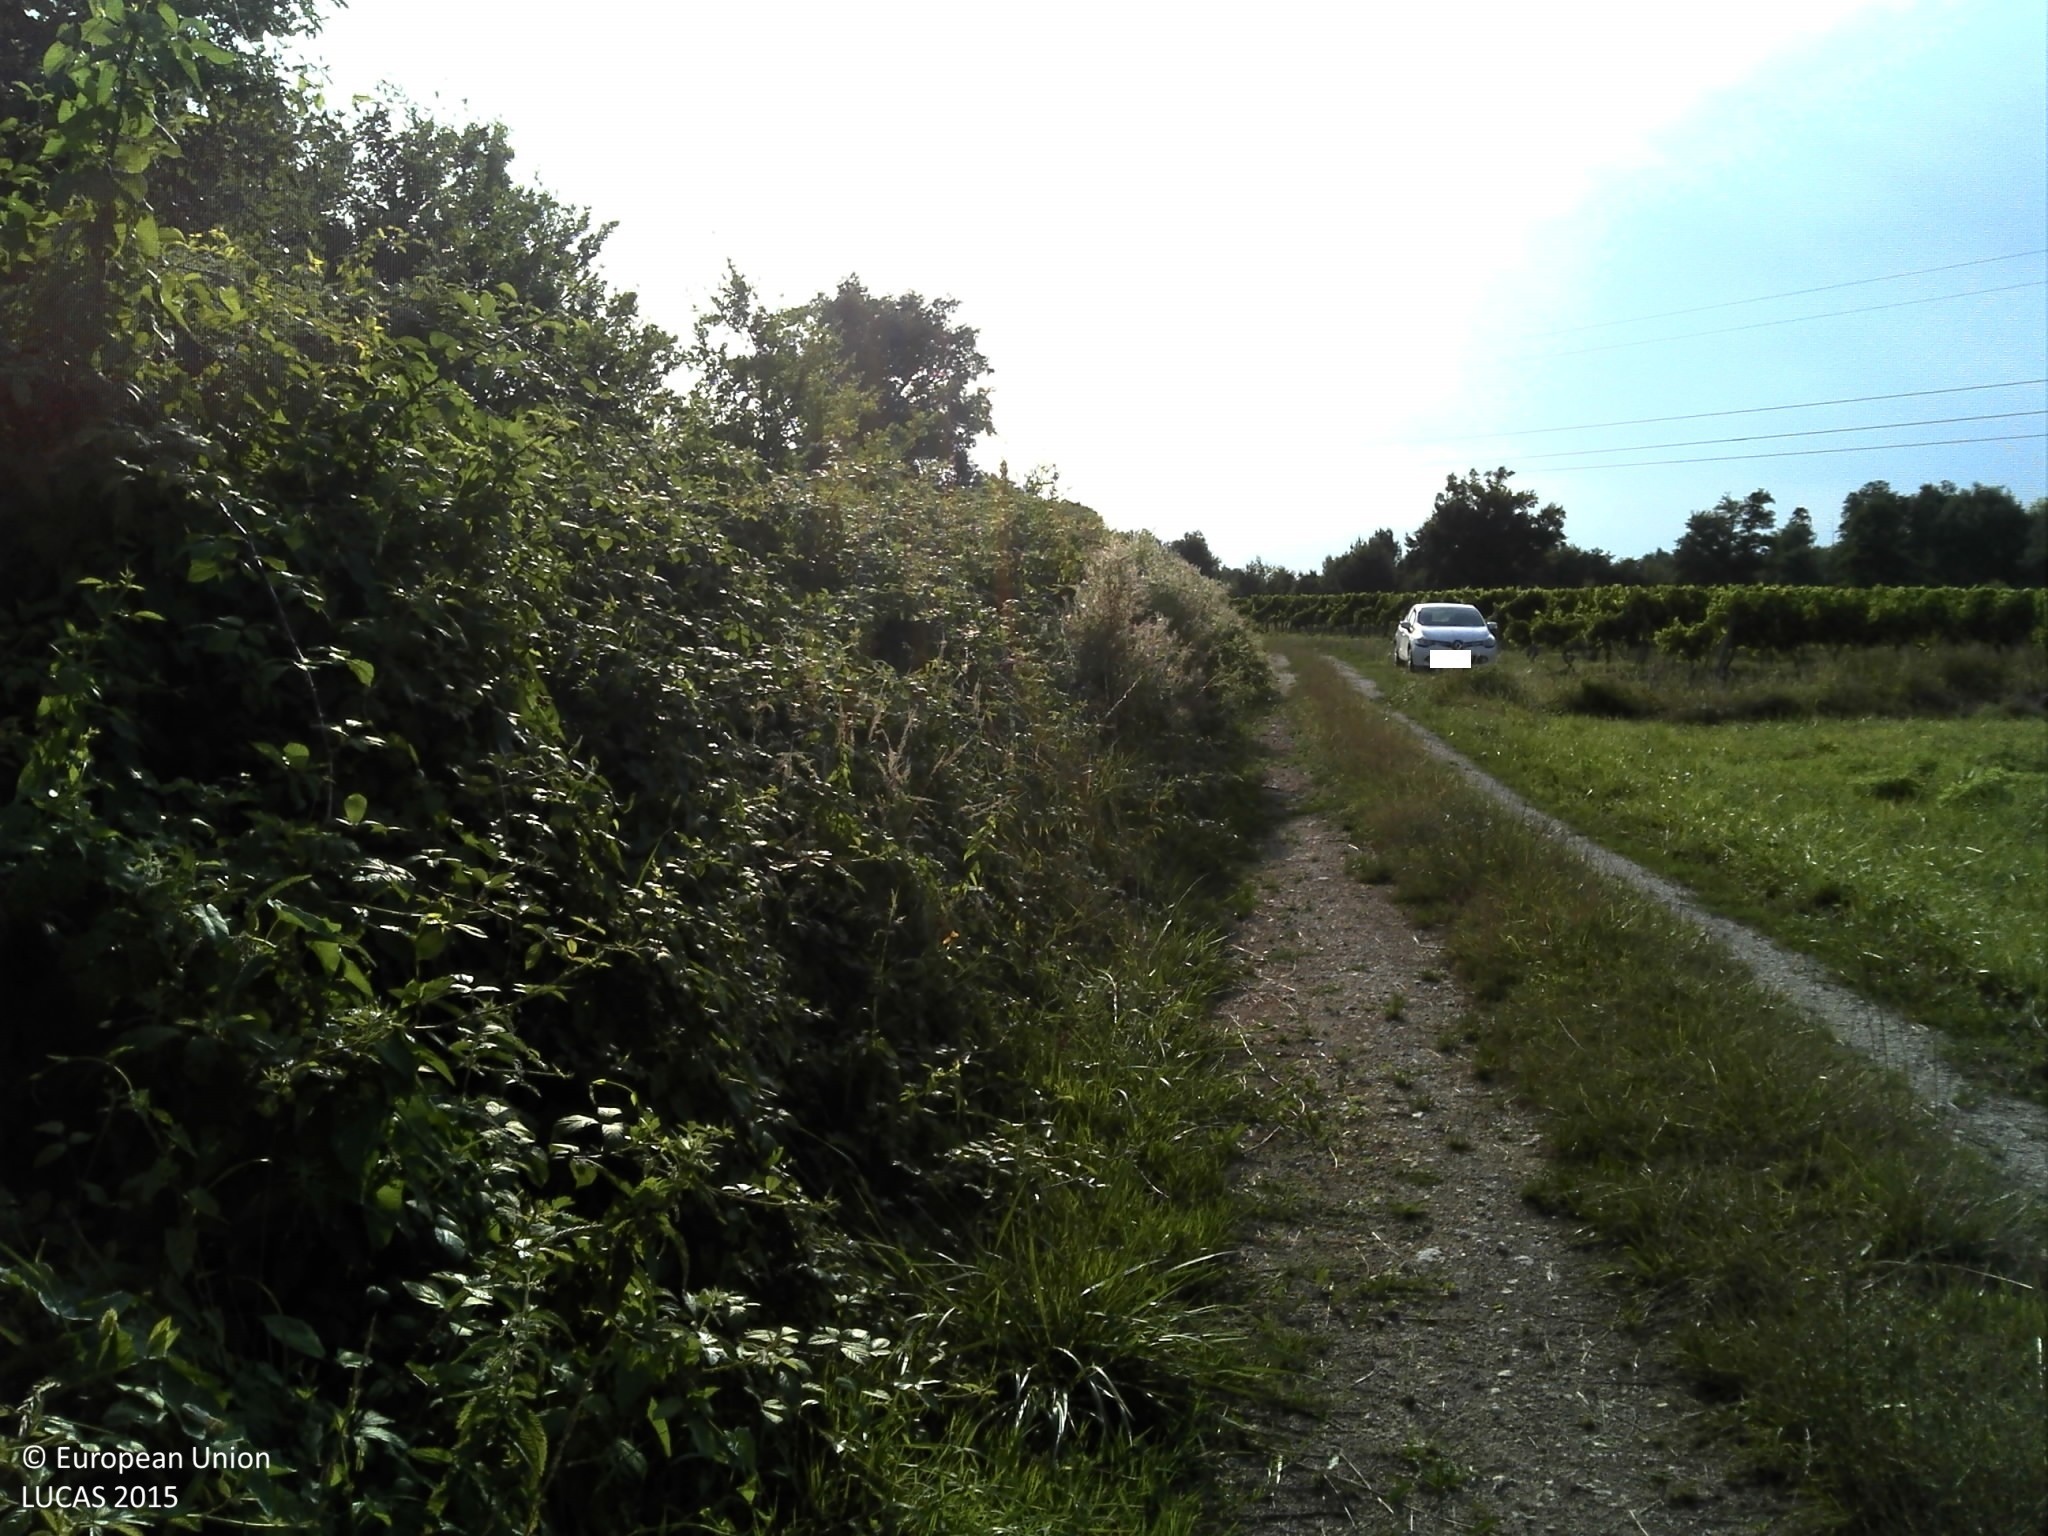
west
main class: Shrubland
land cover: Shrubland with sparse tree cover
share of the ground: > 75 %
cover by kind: shrubs 90 %, broadleaved forest trees 5 %, herbaceous plants 5 %
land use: Semi-natural and natural areas not in use
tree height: > 5 m
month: August
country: FR
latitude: 45.2588
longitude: -0.6110
